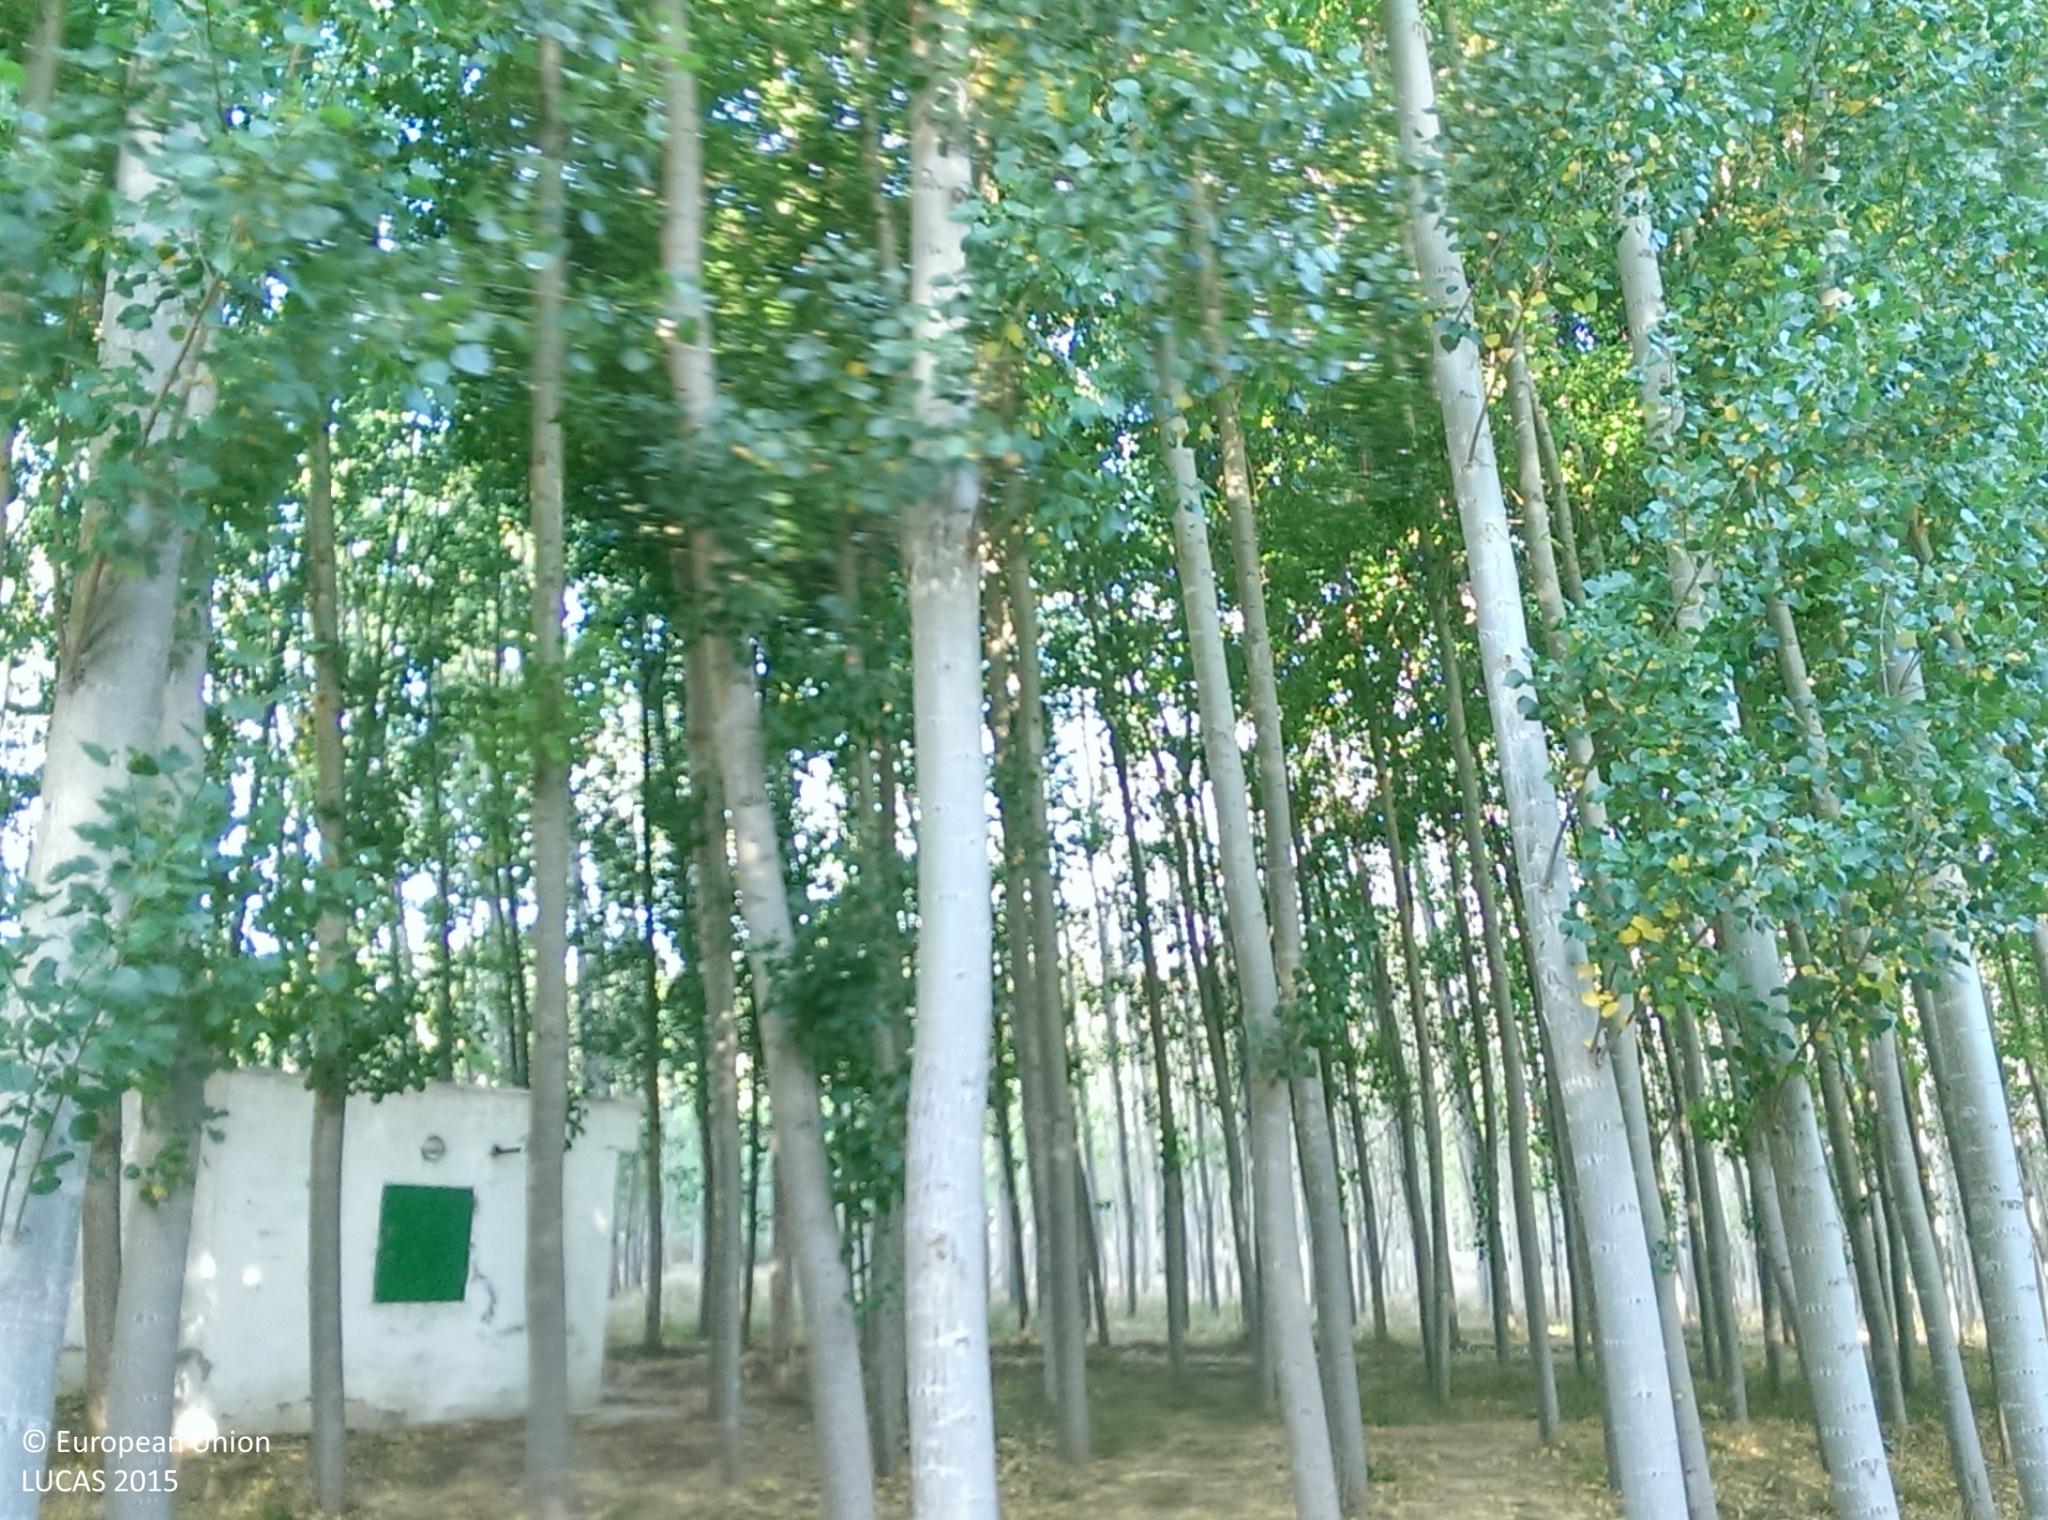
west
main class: Woodland
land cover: Broadleaved woodland
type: exotic forest
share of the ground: > 75 %
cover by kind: broadleaved forest trees 80 %, herbaceous plants 10 %, unconsolidated bare surface 10 %
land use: Forestry
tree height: > 5 m
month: July
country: ES
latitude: 37.3959
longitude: -3.1711
